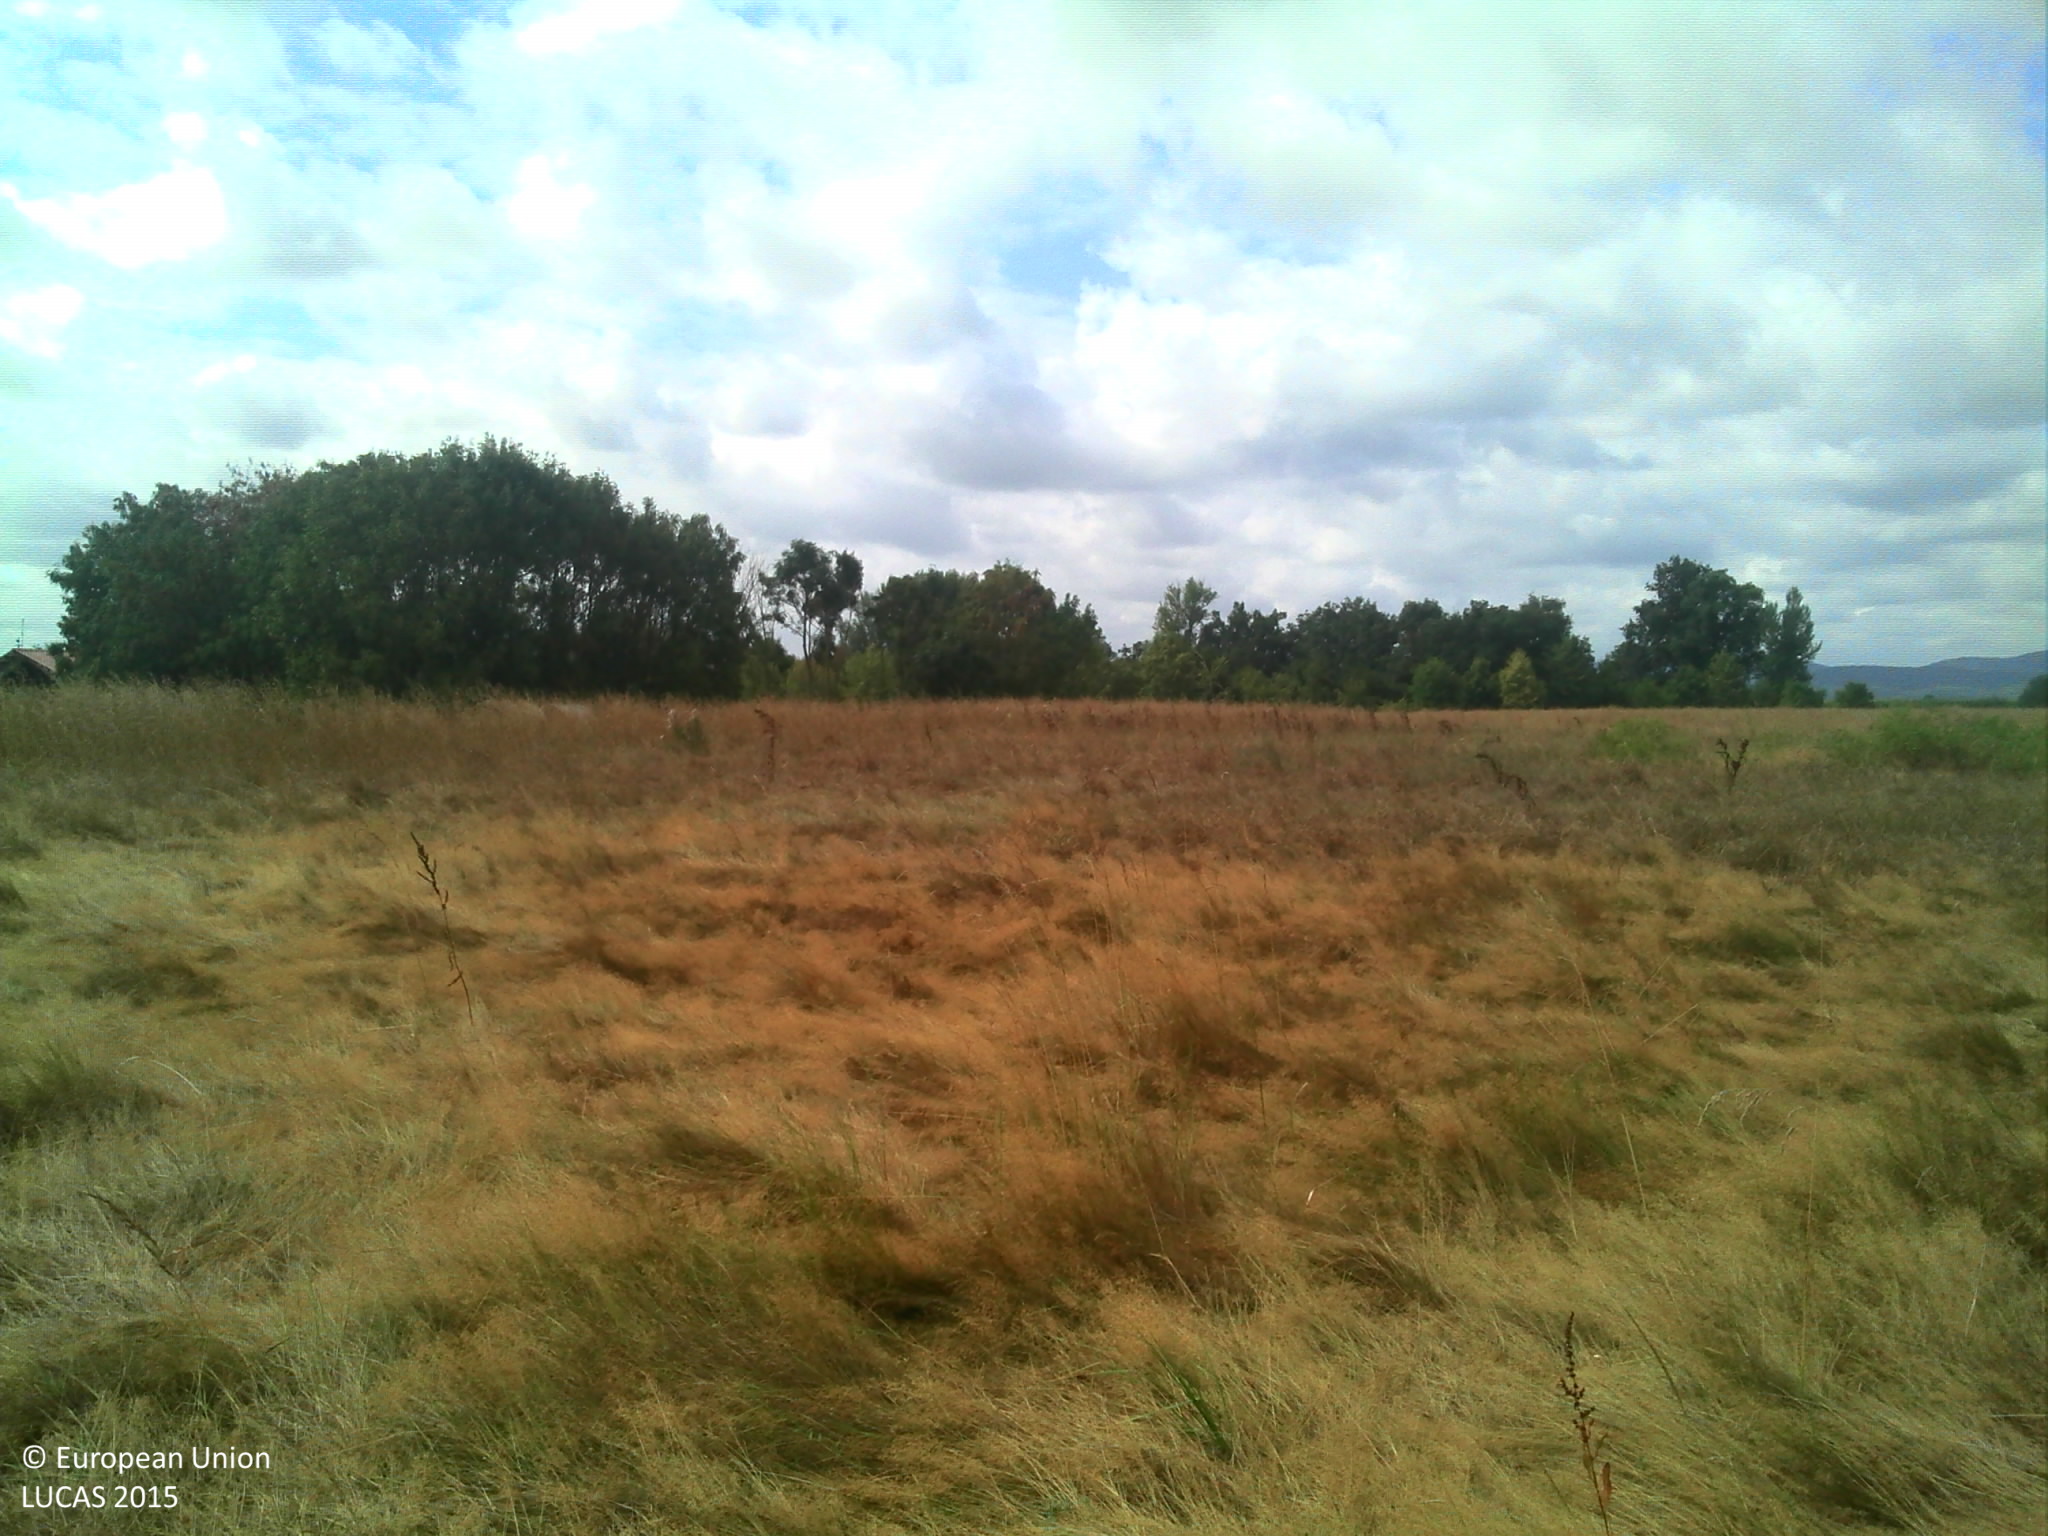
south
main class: Grassland
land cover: Grassland without tree/shrub cover
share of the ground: > 75 %
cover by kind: herbaceous plants 100 %
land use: Agriculture (excluding fallow land and kitchen gardens)
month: July
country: FR
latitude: 43.2418
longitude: 1.0992
